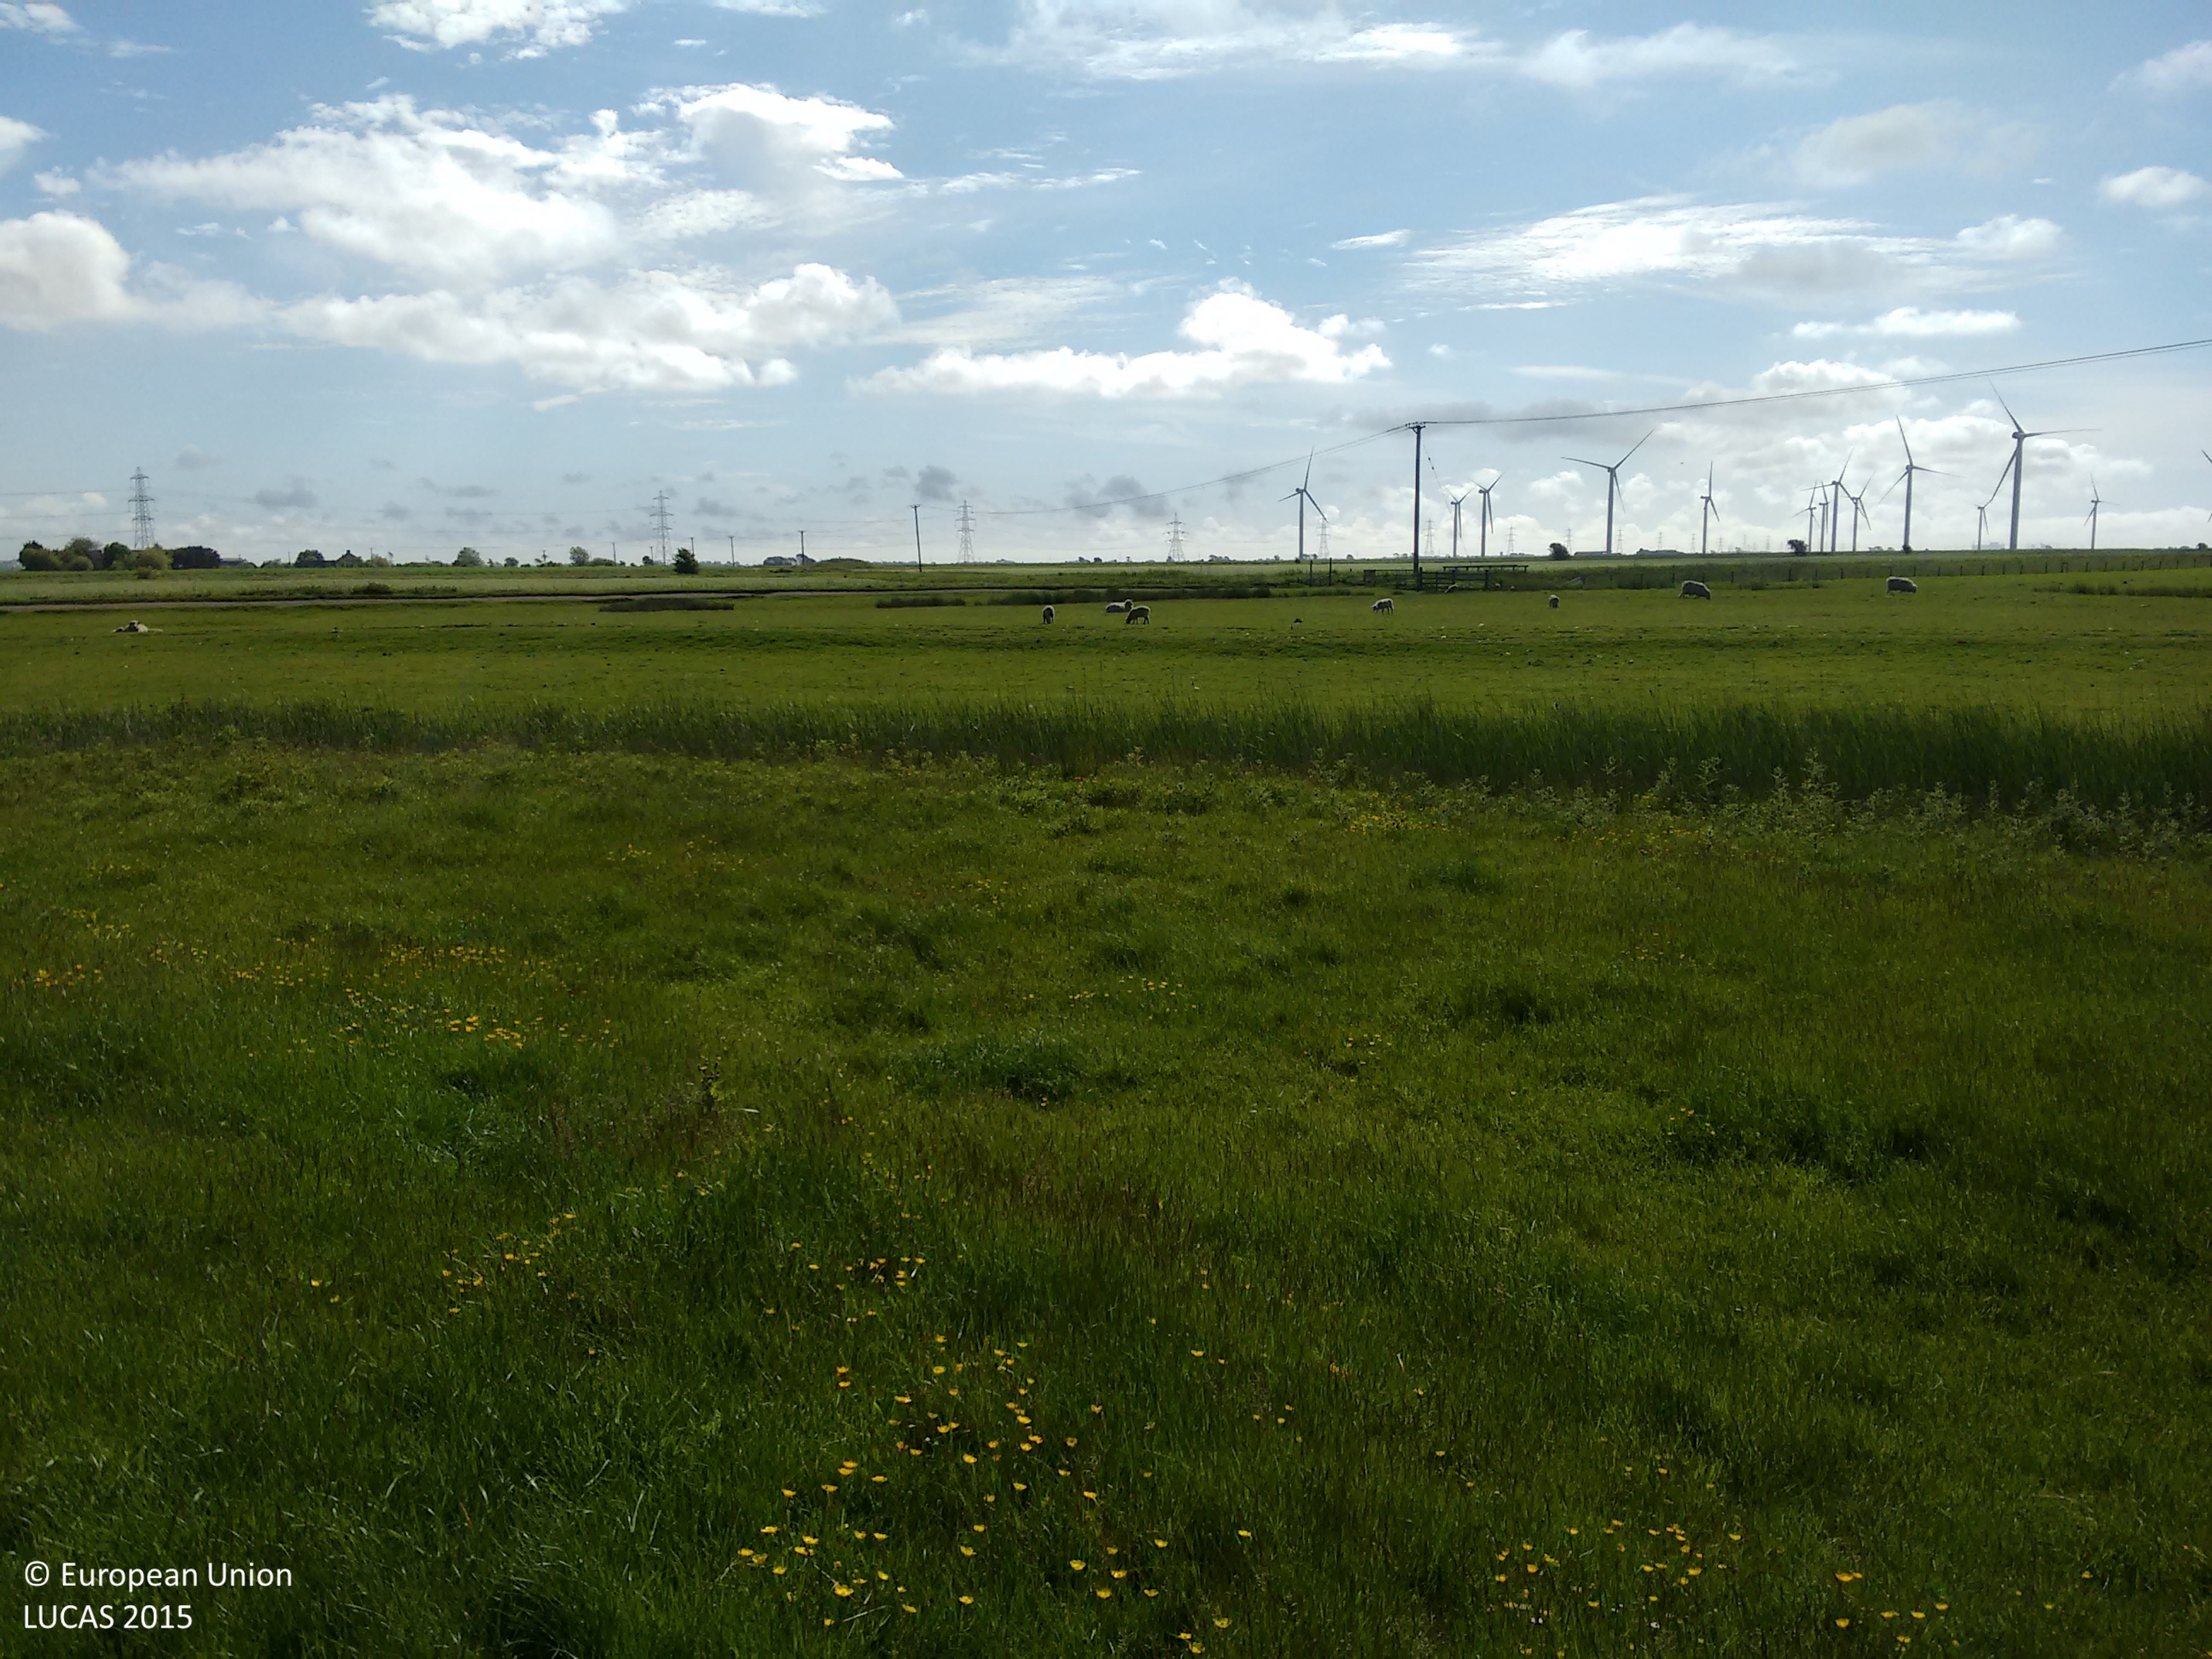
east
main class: Grassland
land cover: Grassland without tree/shrub cover
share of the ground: > 75 %
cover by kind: herbaceous plants 100 %
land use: Agriculture (excluding fallow land and kitchen gardens)
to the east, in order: Grassland without tree/shrub cover; Rivers and streams; Grassland without tree/shrub cover; Tracks; Grassland without tree/shrub cover; Tracks; Grass margins; Ditches and canals; Grass margins; Common wheat; Grass margins; Tracks; Grassland without tree/shrub cover; Electric lines; Ditches and canals; Grass margins; Common wheat
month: June
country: GB
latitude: 50.9691
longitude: 0.7899
